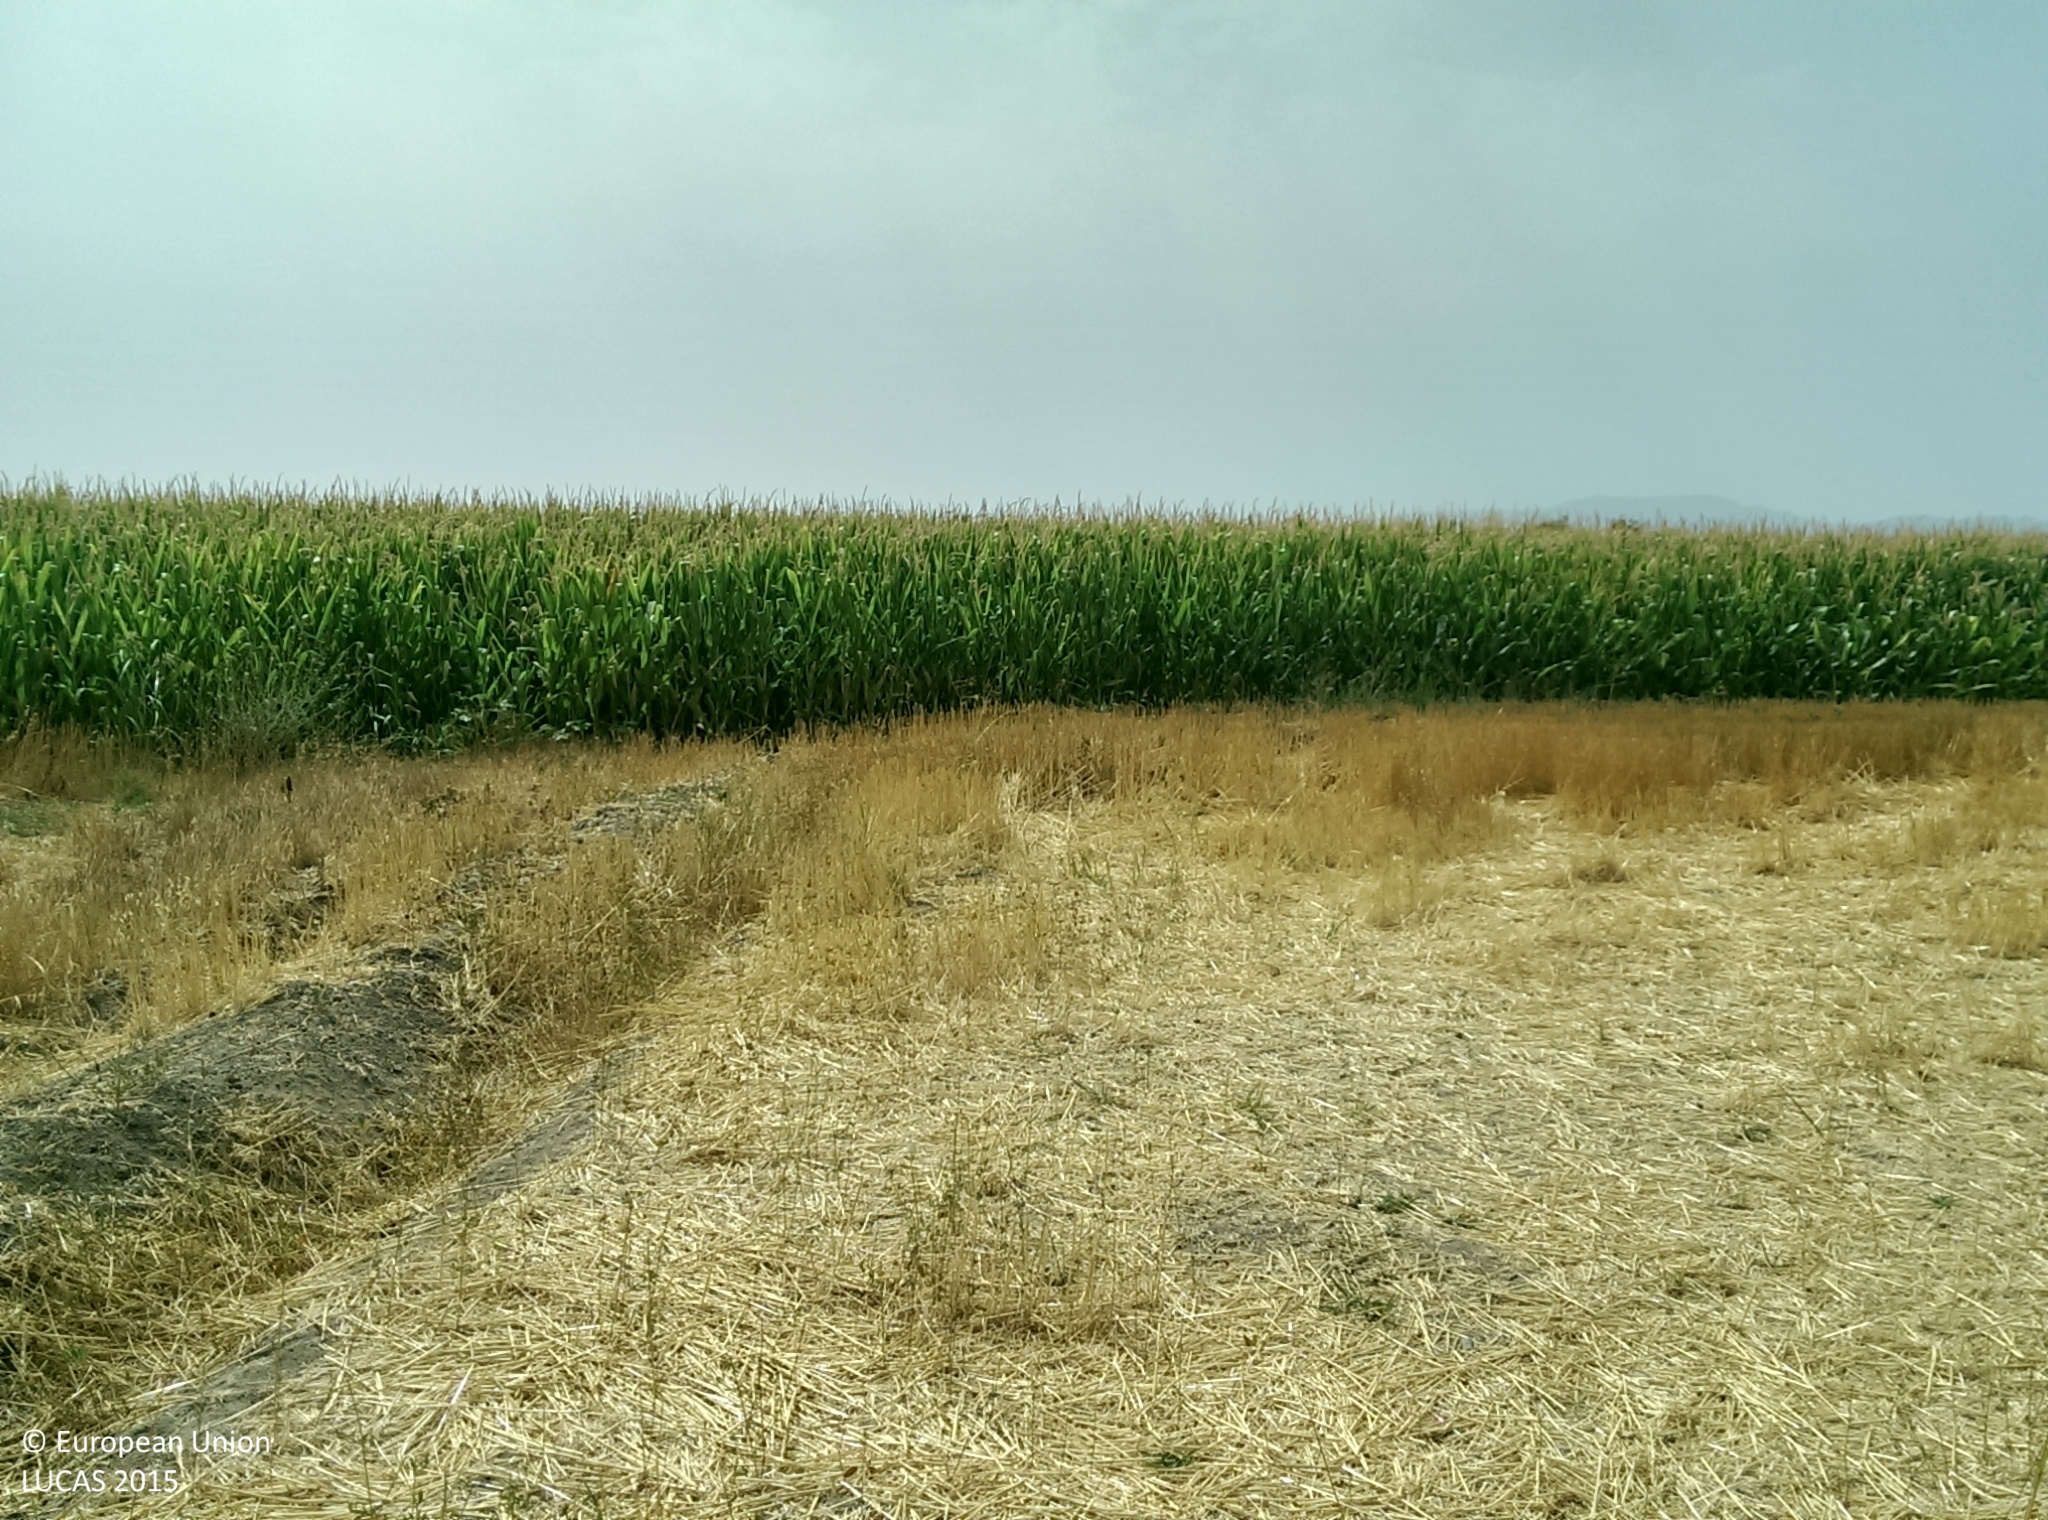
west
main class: Cropland
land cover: Common wheat
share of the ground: < 10 %
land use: Agriculture (excluding fallow land and kitchen gardens)
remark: Harvested field
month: August
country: ES
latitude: 37.1738
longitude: -3.6968
